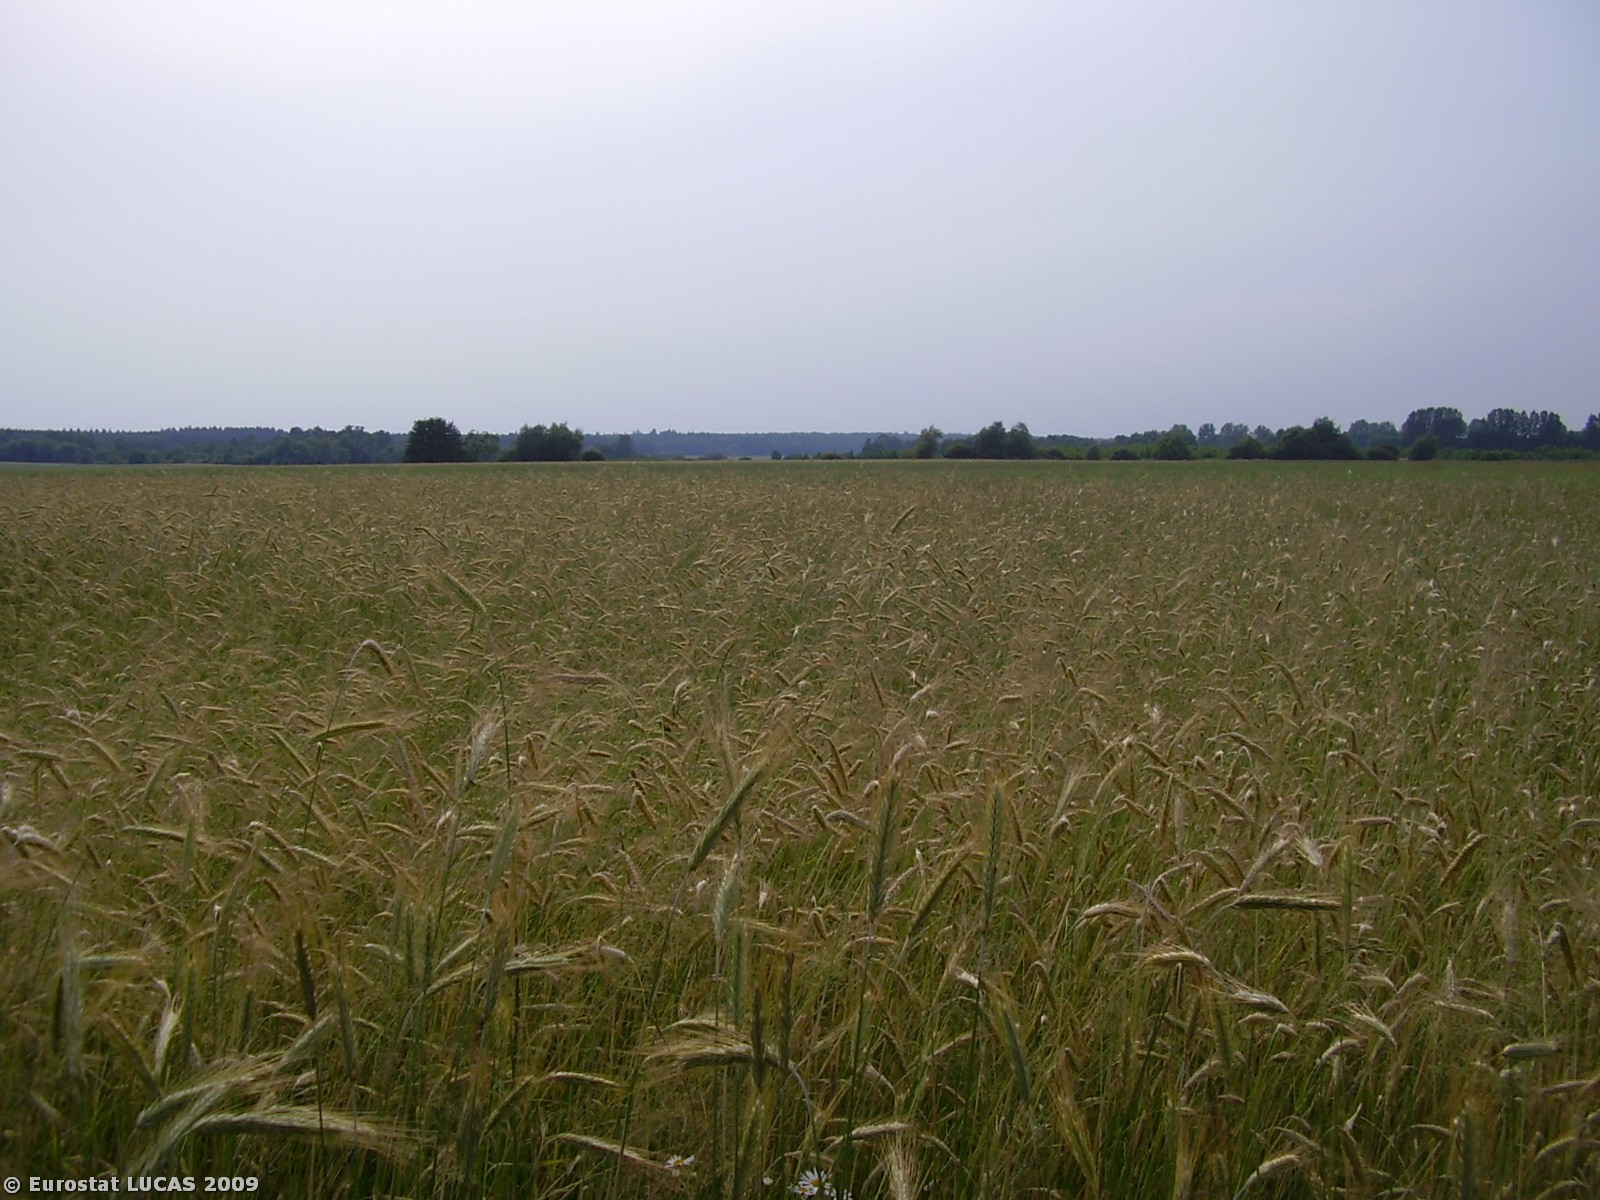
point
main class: Cropland
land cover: Rye
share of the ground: > 75 %
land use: Agriculture (excluding fallow land and kitchen gardens)
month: July
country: PL
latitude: 51.5671
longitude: 16.8331
